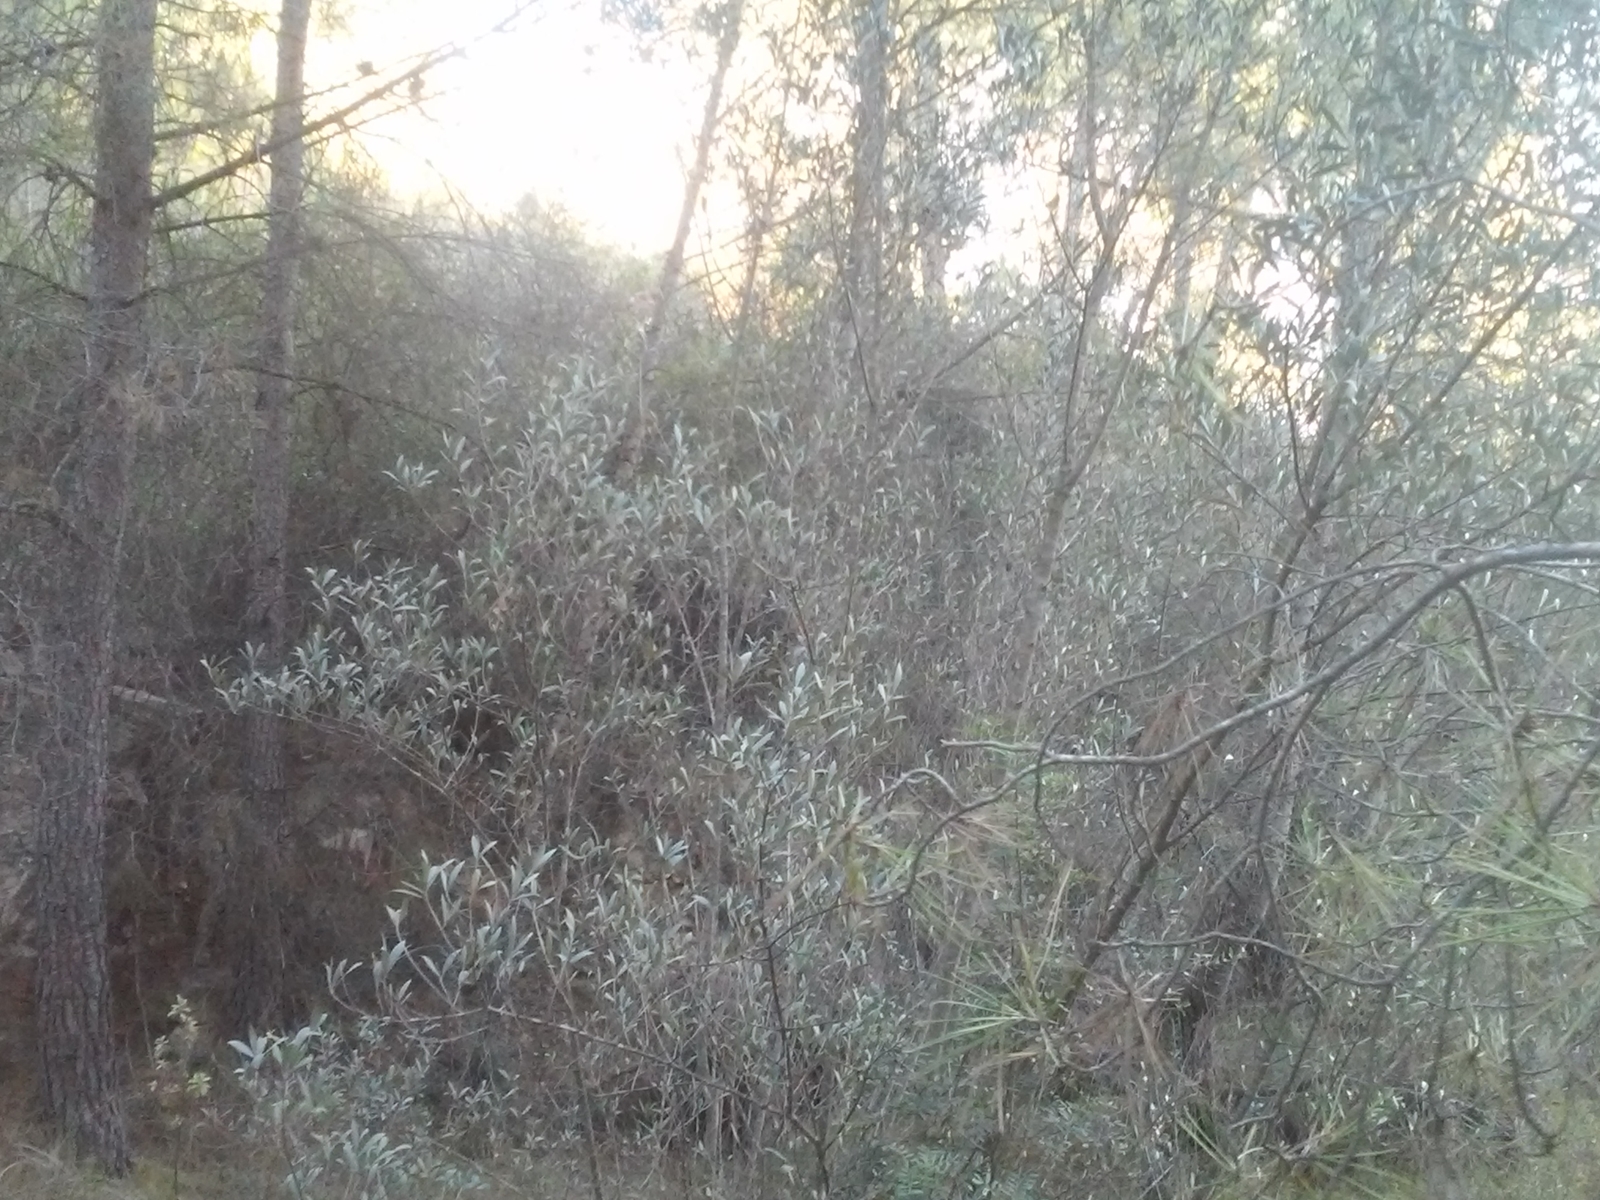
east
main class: Woodland
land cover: Pine dominated coniferous woodland
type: coniferous forest of the mediterranean region
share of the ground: 50 - 75 %
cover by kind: coniferous forest trees 50 %, shrubs 35 %, herbaceous plants 10 %, broadleaved forest trees 5 %
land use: Semi-natural and natural areas not in use
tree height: < 5 m
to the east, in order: Pine dominated coniferous woodland; Shrubland with sparse tree cover; Nuts trees; Shrubland with sparse tree cover; Nuts trees; Pine dominated coniferous woodland; Nuts trees; Dry stone walls; Pine dominated coniferous woodland
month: September
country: ES
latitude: 41.1672
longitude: 0.6591
